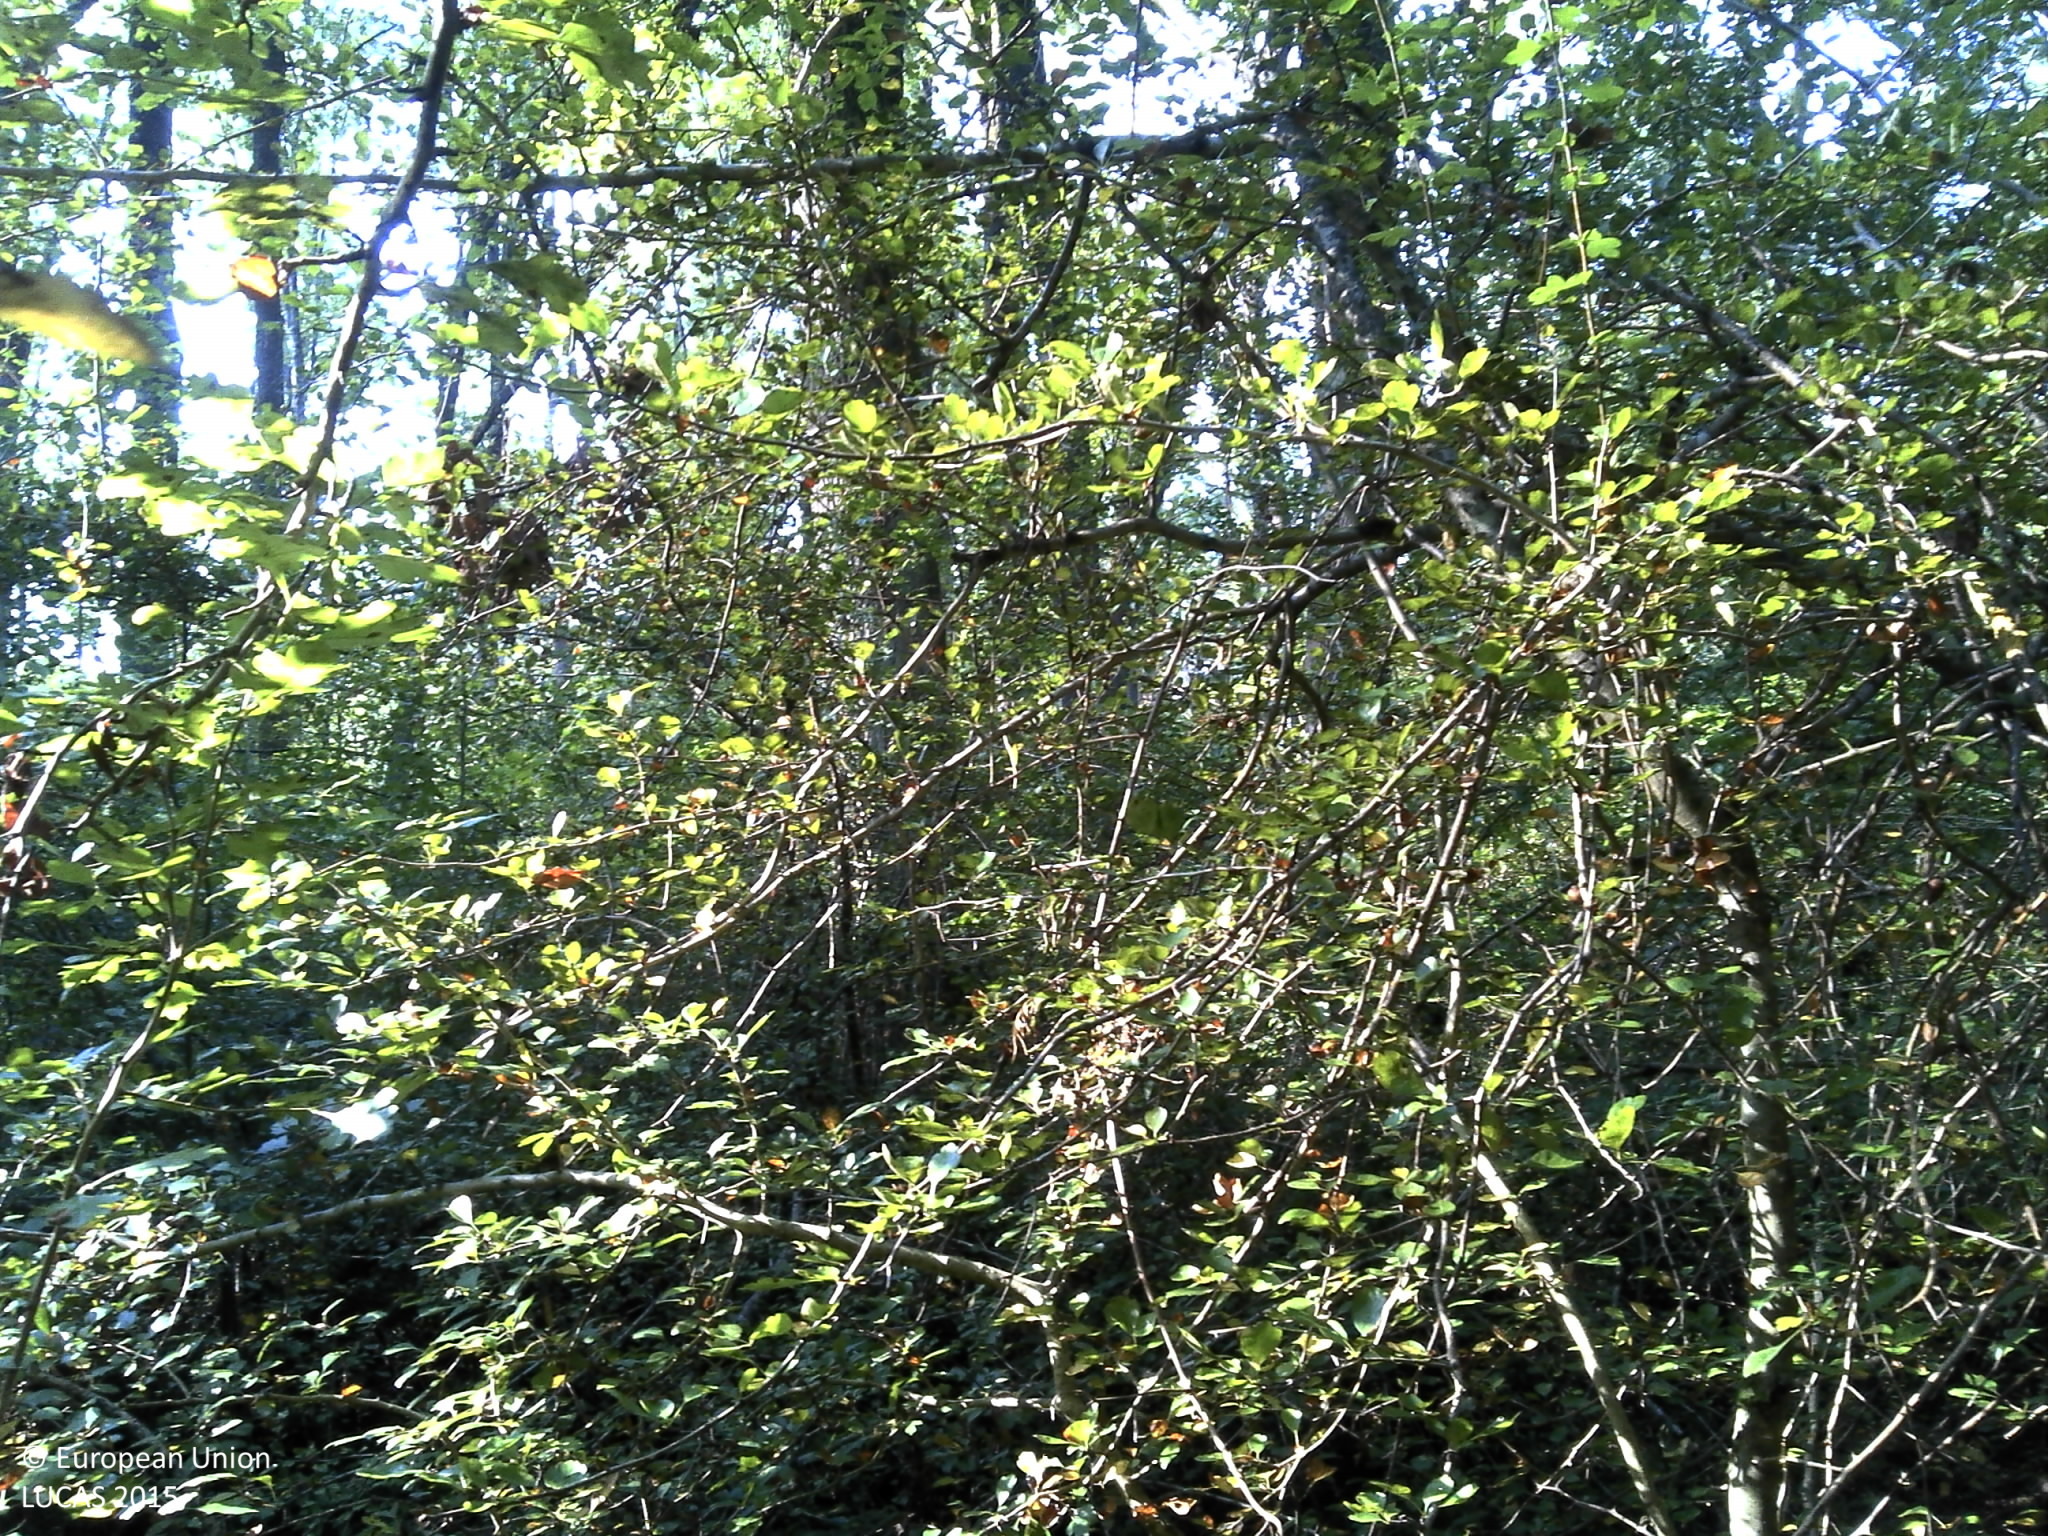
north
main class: Woodland
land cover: Broadleaved woodland
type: acidophilous oak and oak-birch forest
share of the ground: > 75 %
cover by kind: broadleaved forest trees 100 %
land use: Forestry
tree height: > 5 m
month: August
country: HR
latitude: 45.5519
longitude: 16.2873
